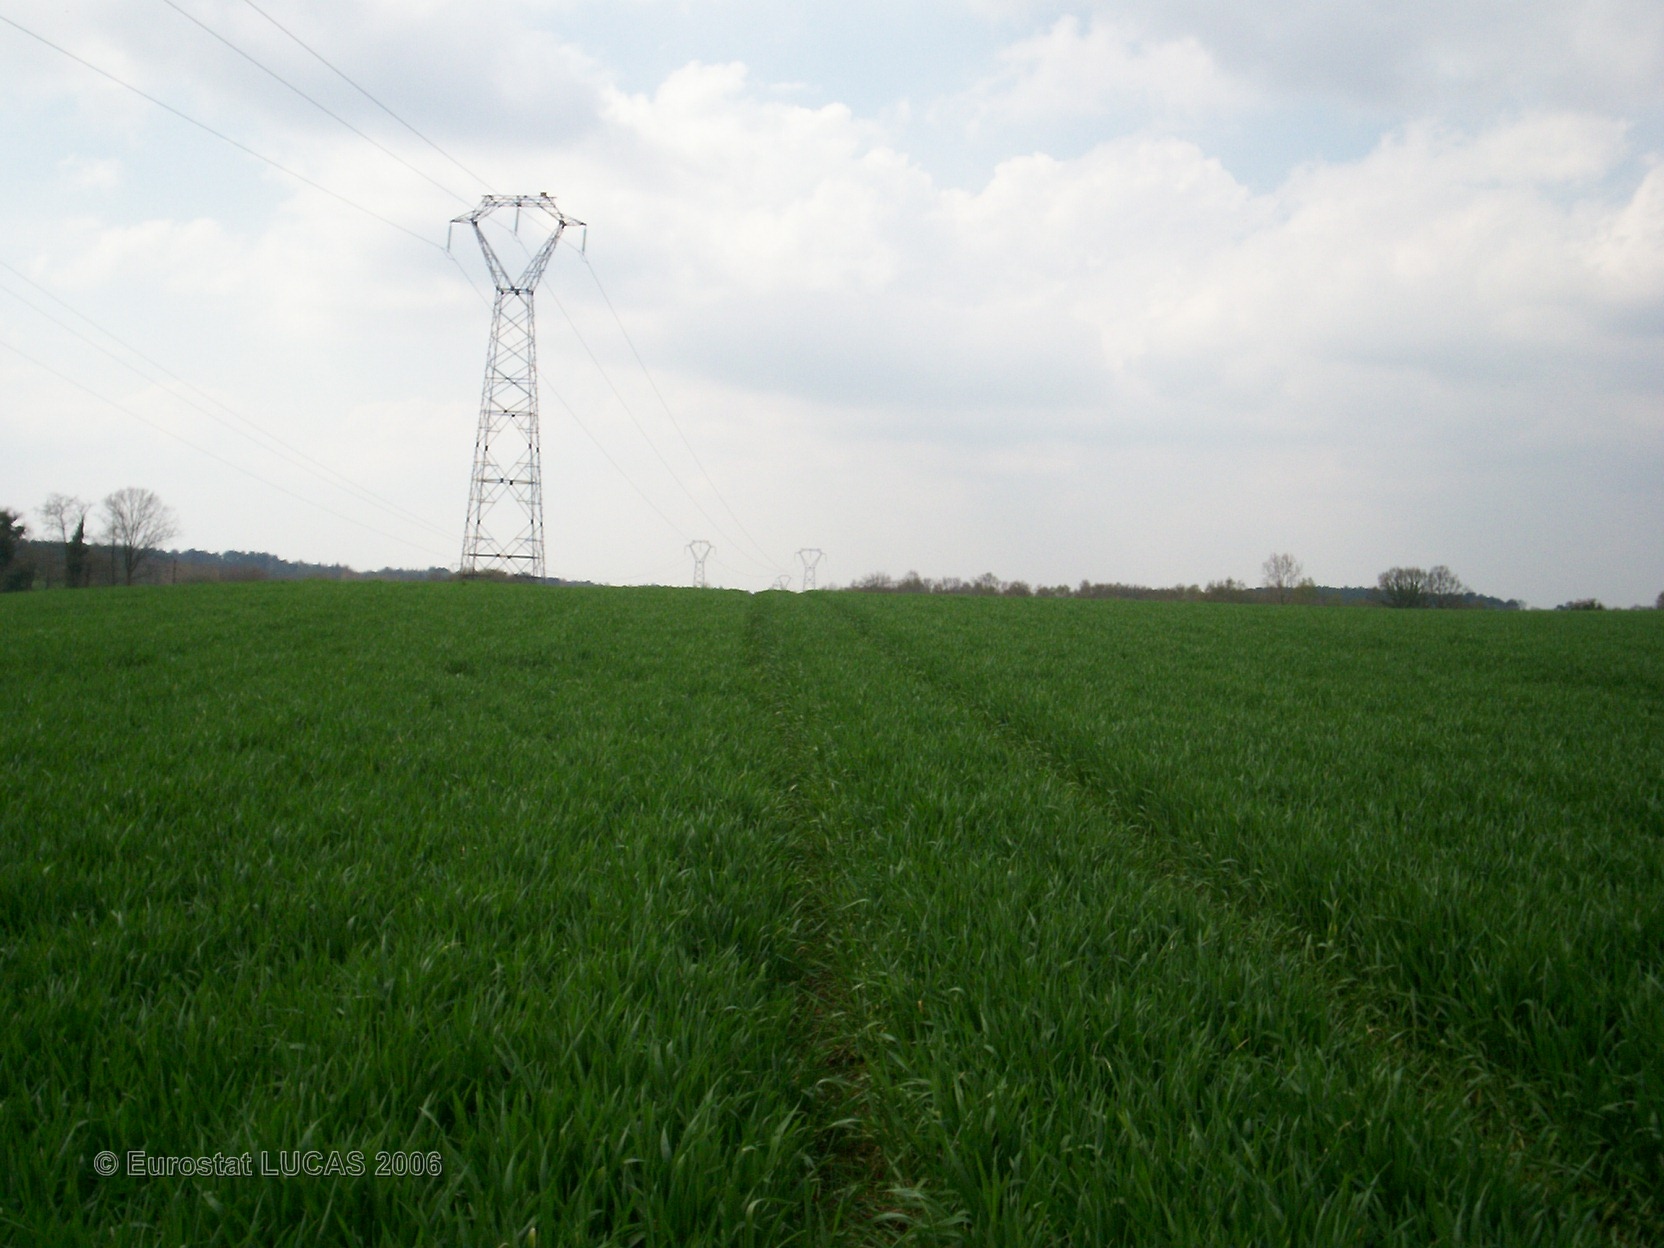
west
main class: Cropland
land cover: Triticale
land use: Agriculture (excluding fallow land and kitchen gardens)
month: April
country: FR
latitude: 47.6708
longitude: -2.6731
